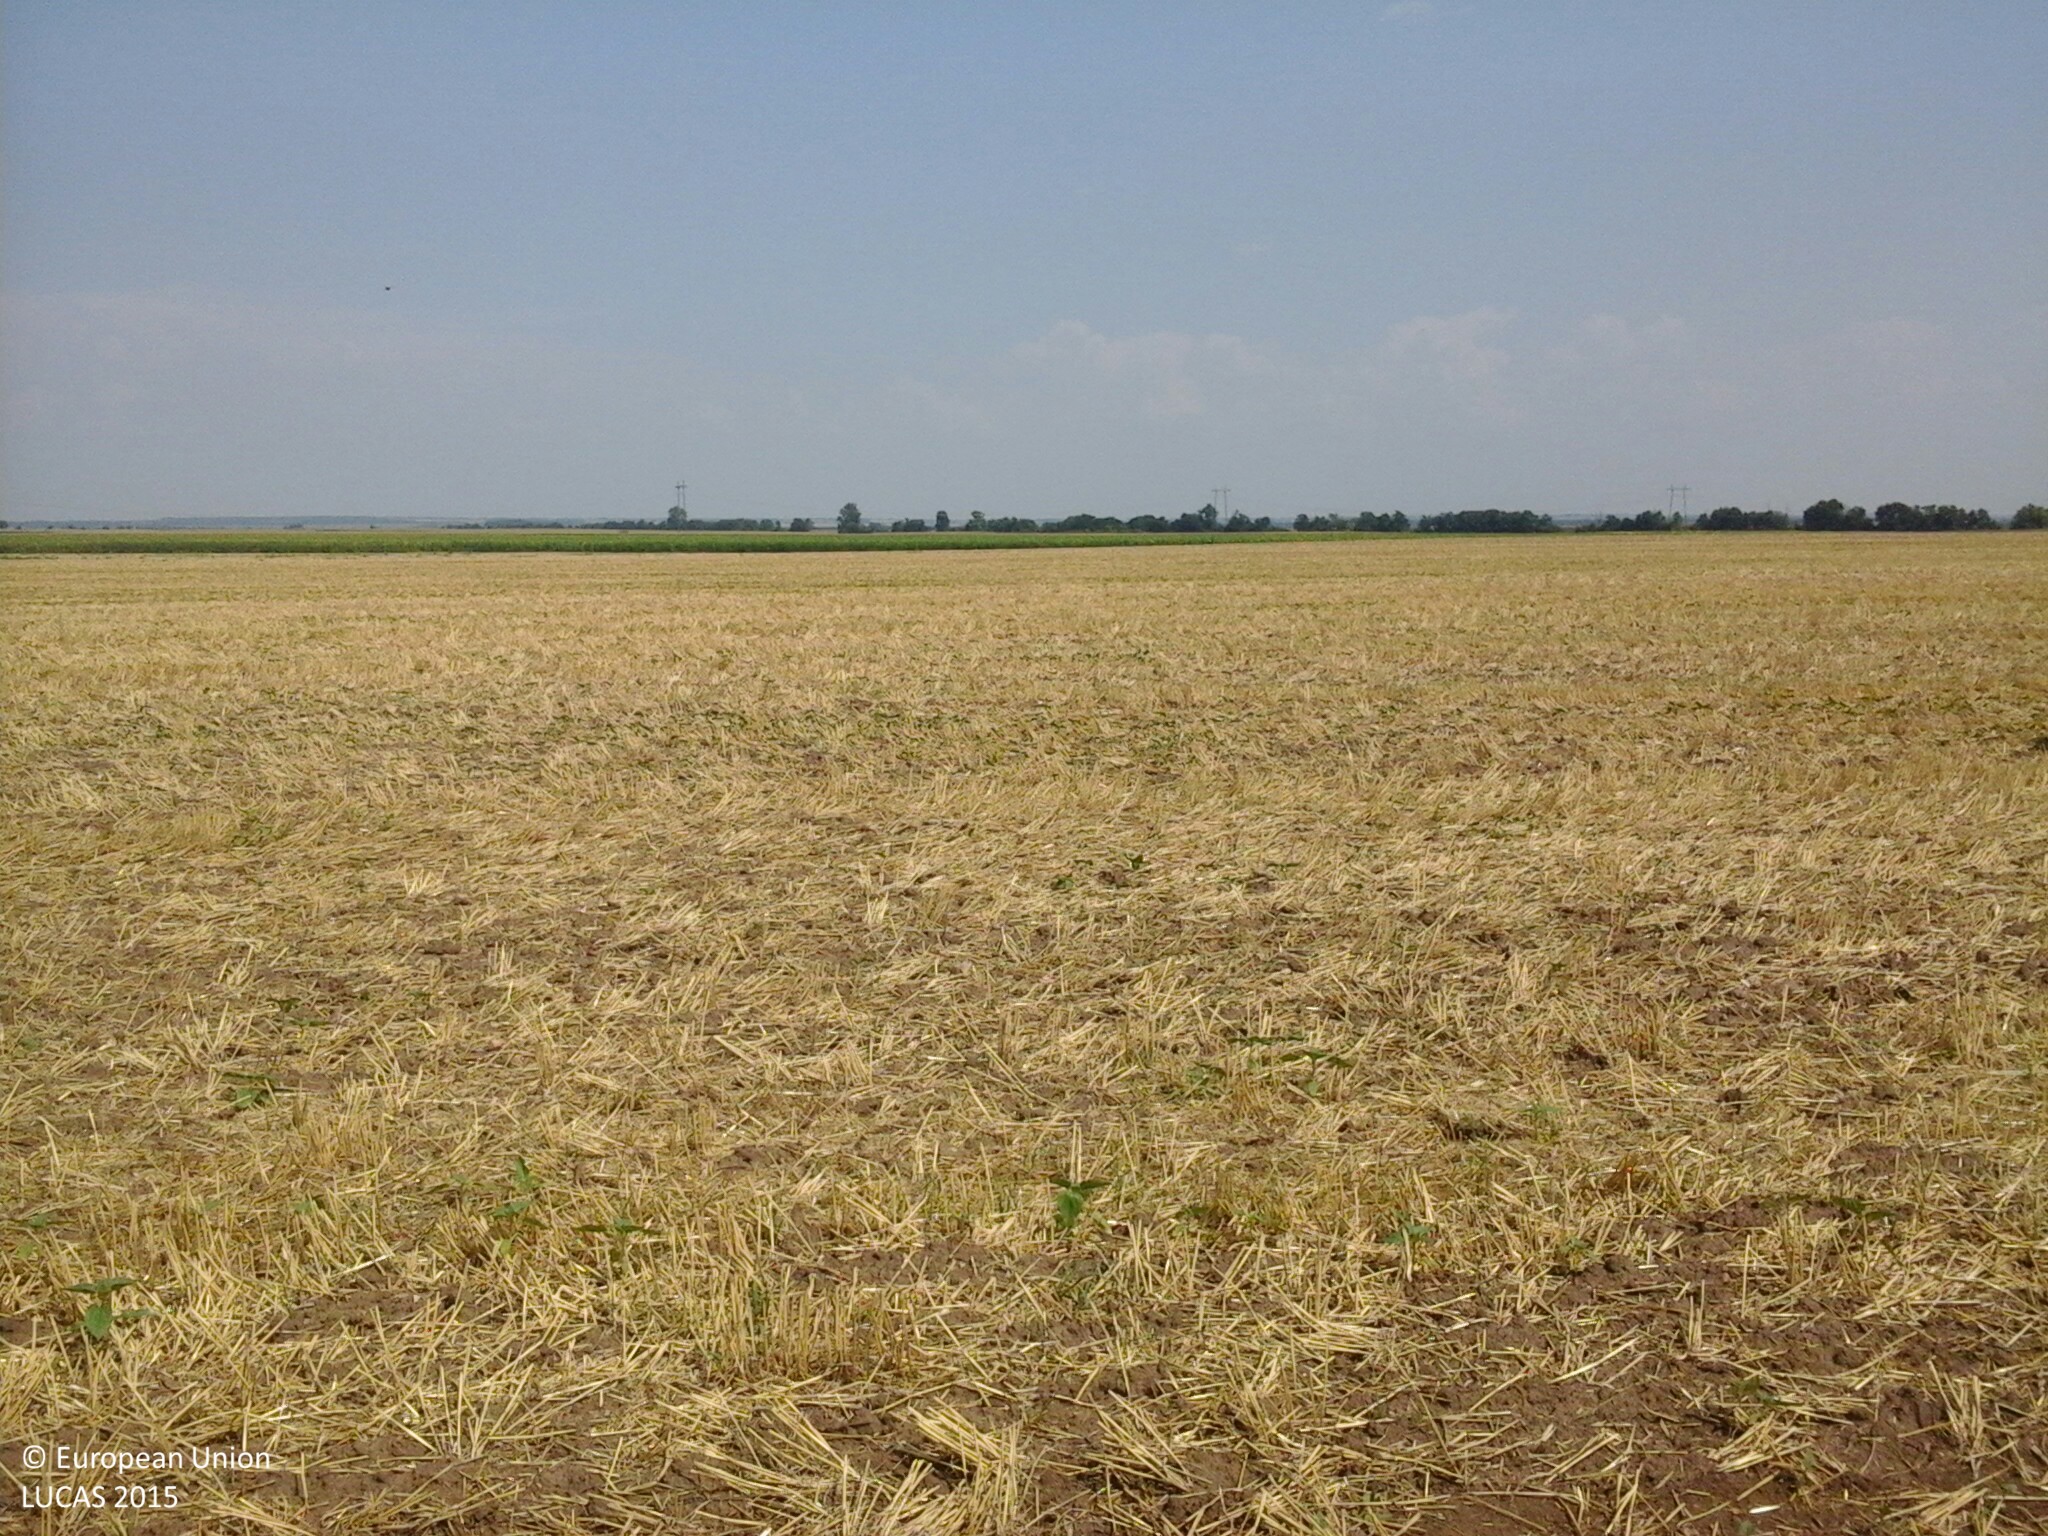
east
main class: Cropland
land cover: Common wheat
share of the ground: < 10 %
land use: Agriculture (excluding fallow land and kitchen gardens)
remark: Harvested field
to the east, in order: Common wheat
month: August
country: HU
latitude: 46.8756
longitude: 18.3424
